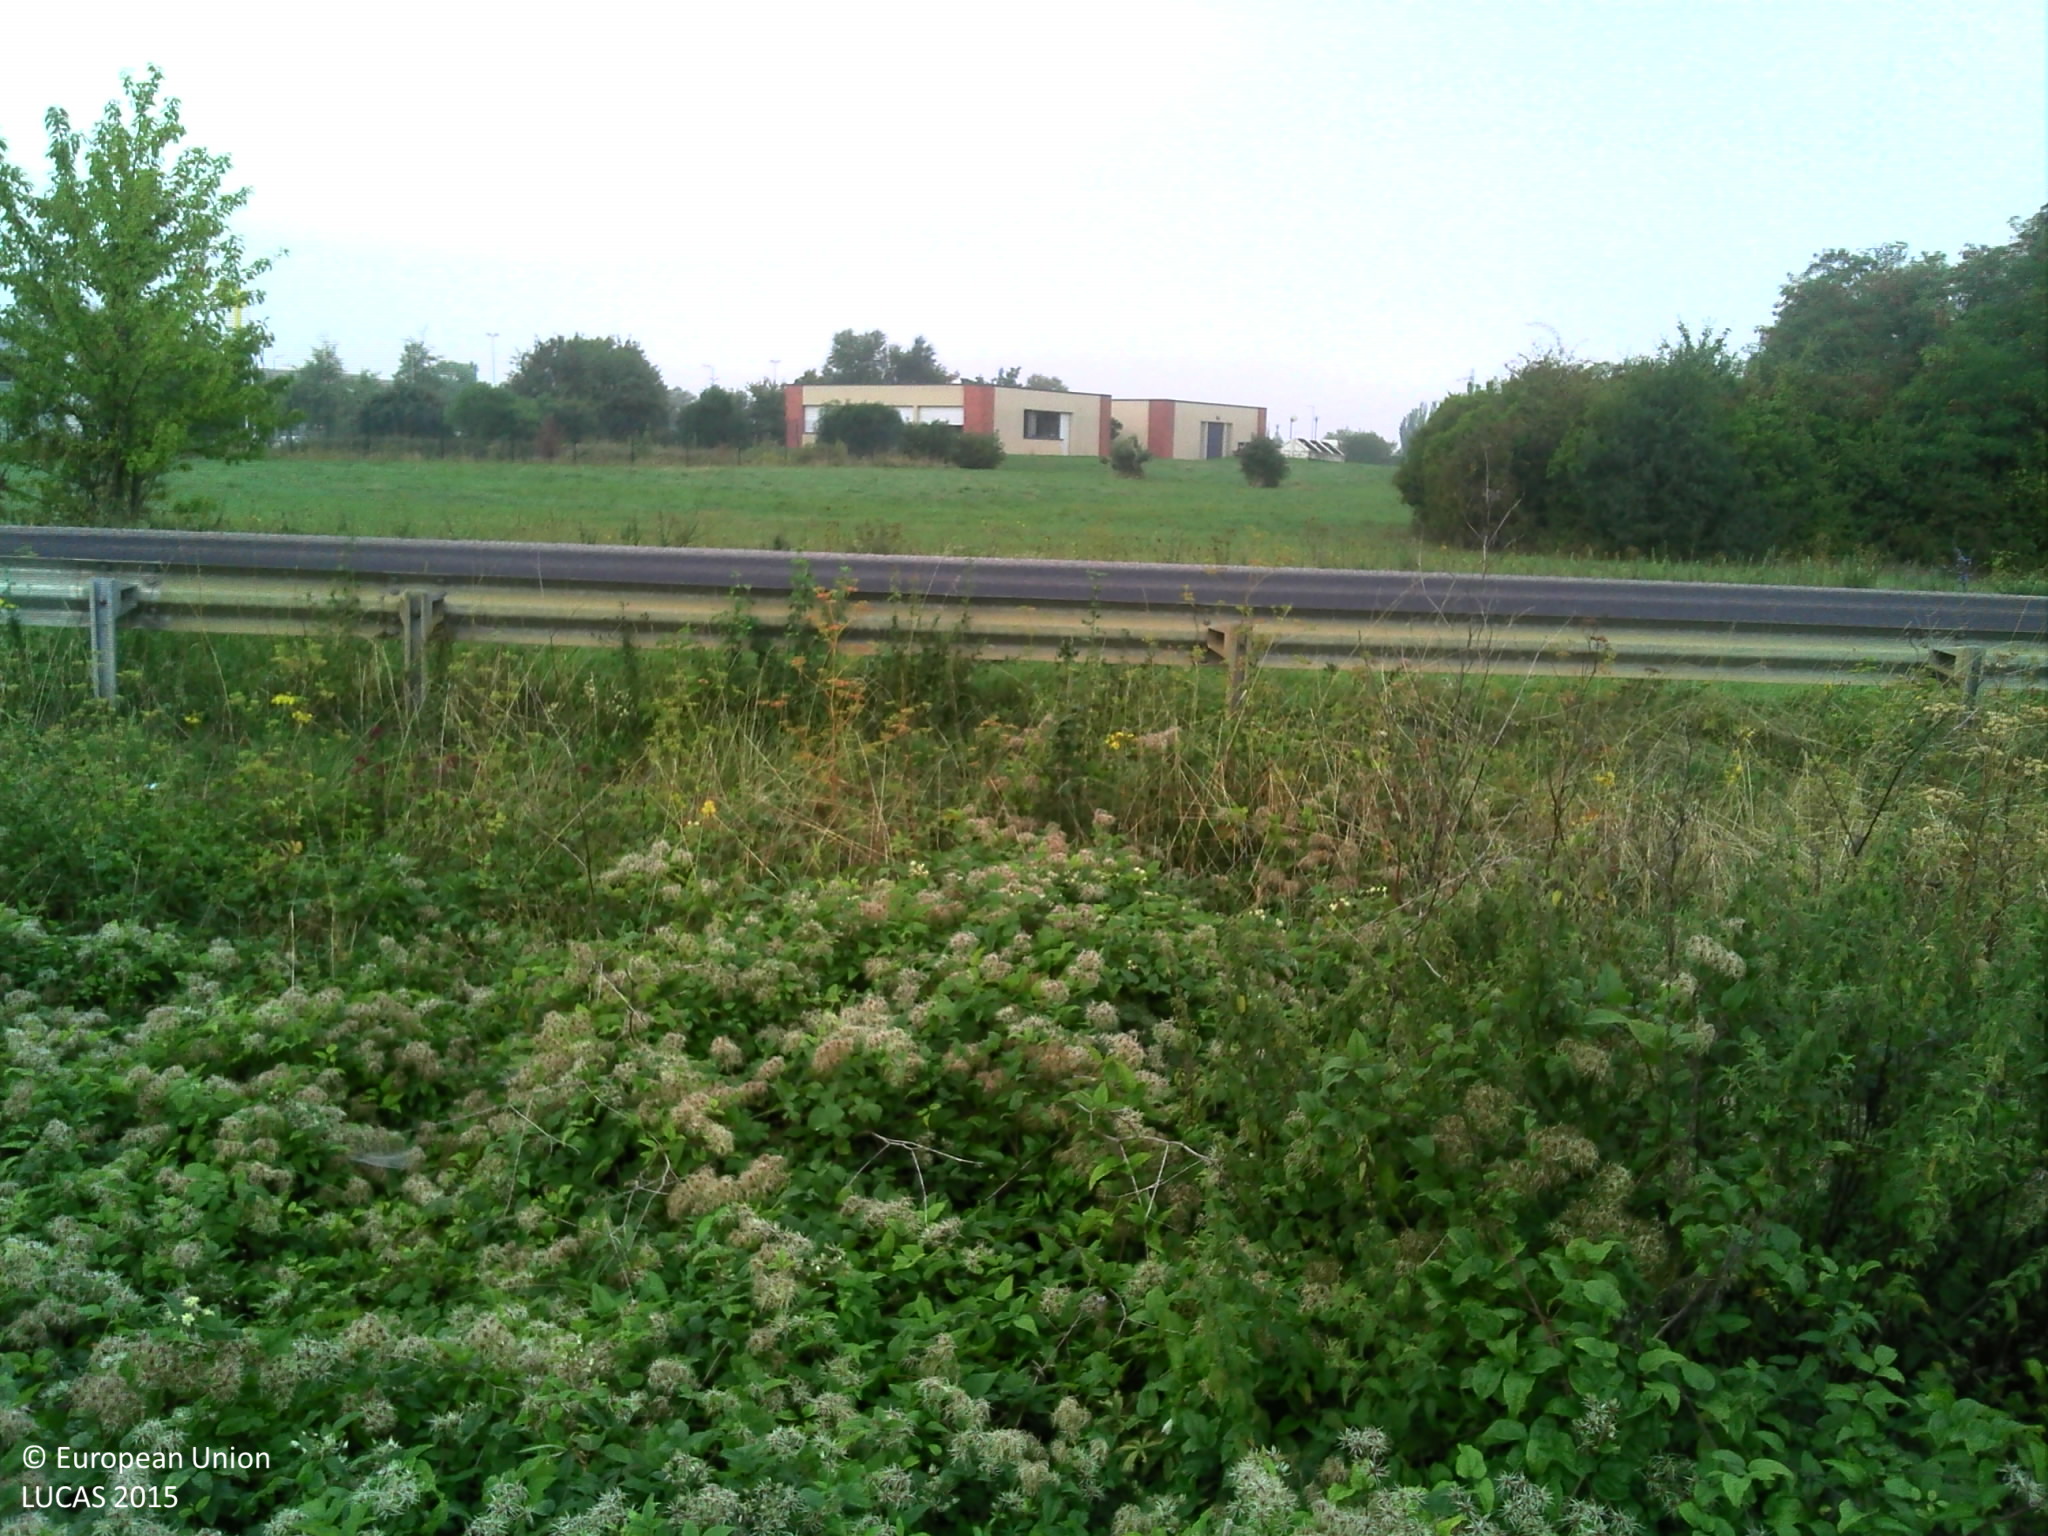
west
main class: Shrubland
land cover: Shrubland without tree cover
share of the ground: 50 - 75 %
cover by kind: shrubs 80 %, herbaceous plants 10 %, consolidated bare surface 5 %, unconsolidated bare surface 5 %
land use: Semi-natural and natural areas not in use
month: September
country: FR
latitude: 49.1770
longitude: 5.9802
